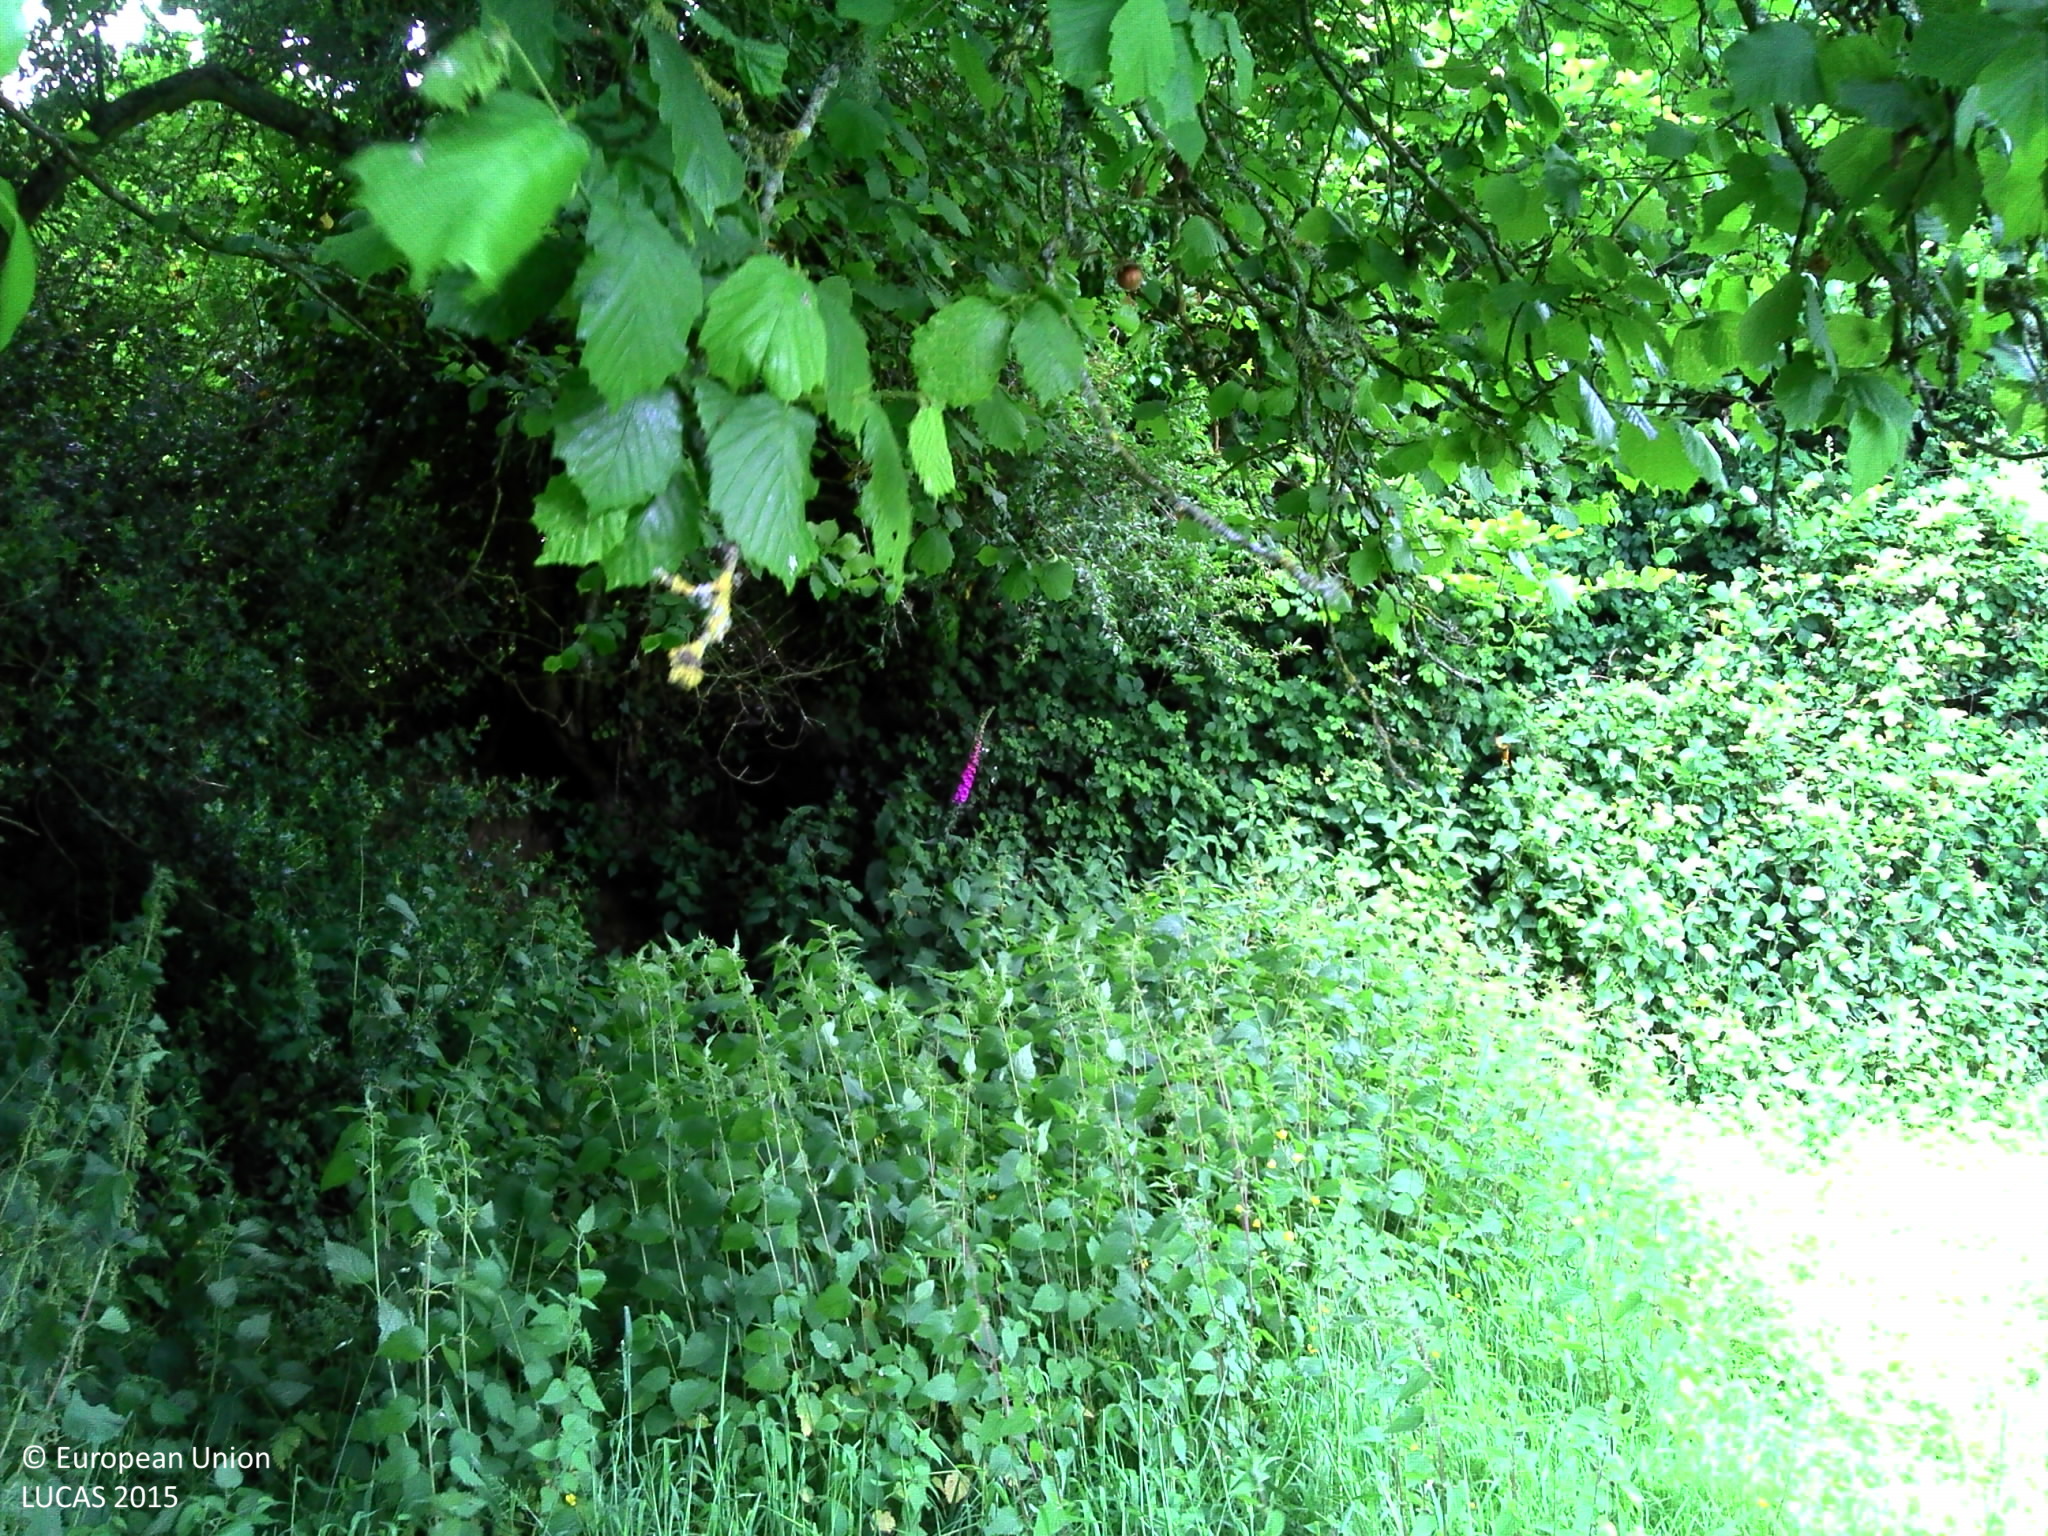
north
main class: Woodland
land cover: Broadleaved woodland
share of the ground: > 75 %
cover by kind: broadleaved forest trees 90 %, shrubs 5 %, herbaceous plants 5 %
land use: Residential
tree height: > 5 m
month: June
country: FR
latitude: 49.5832
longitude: -1.4881
